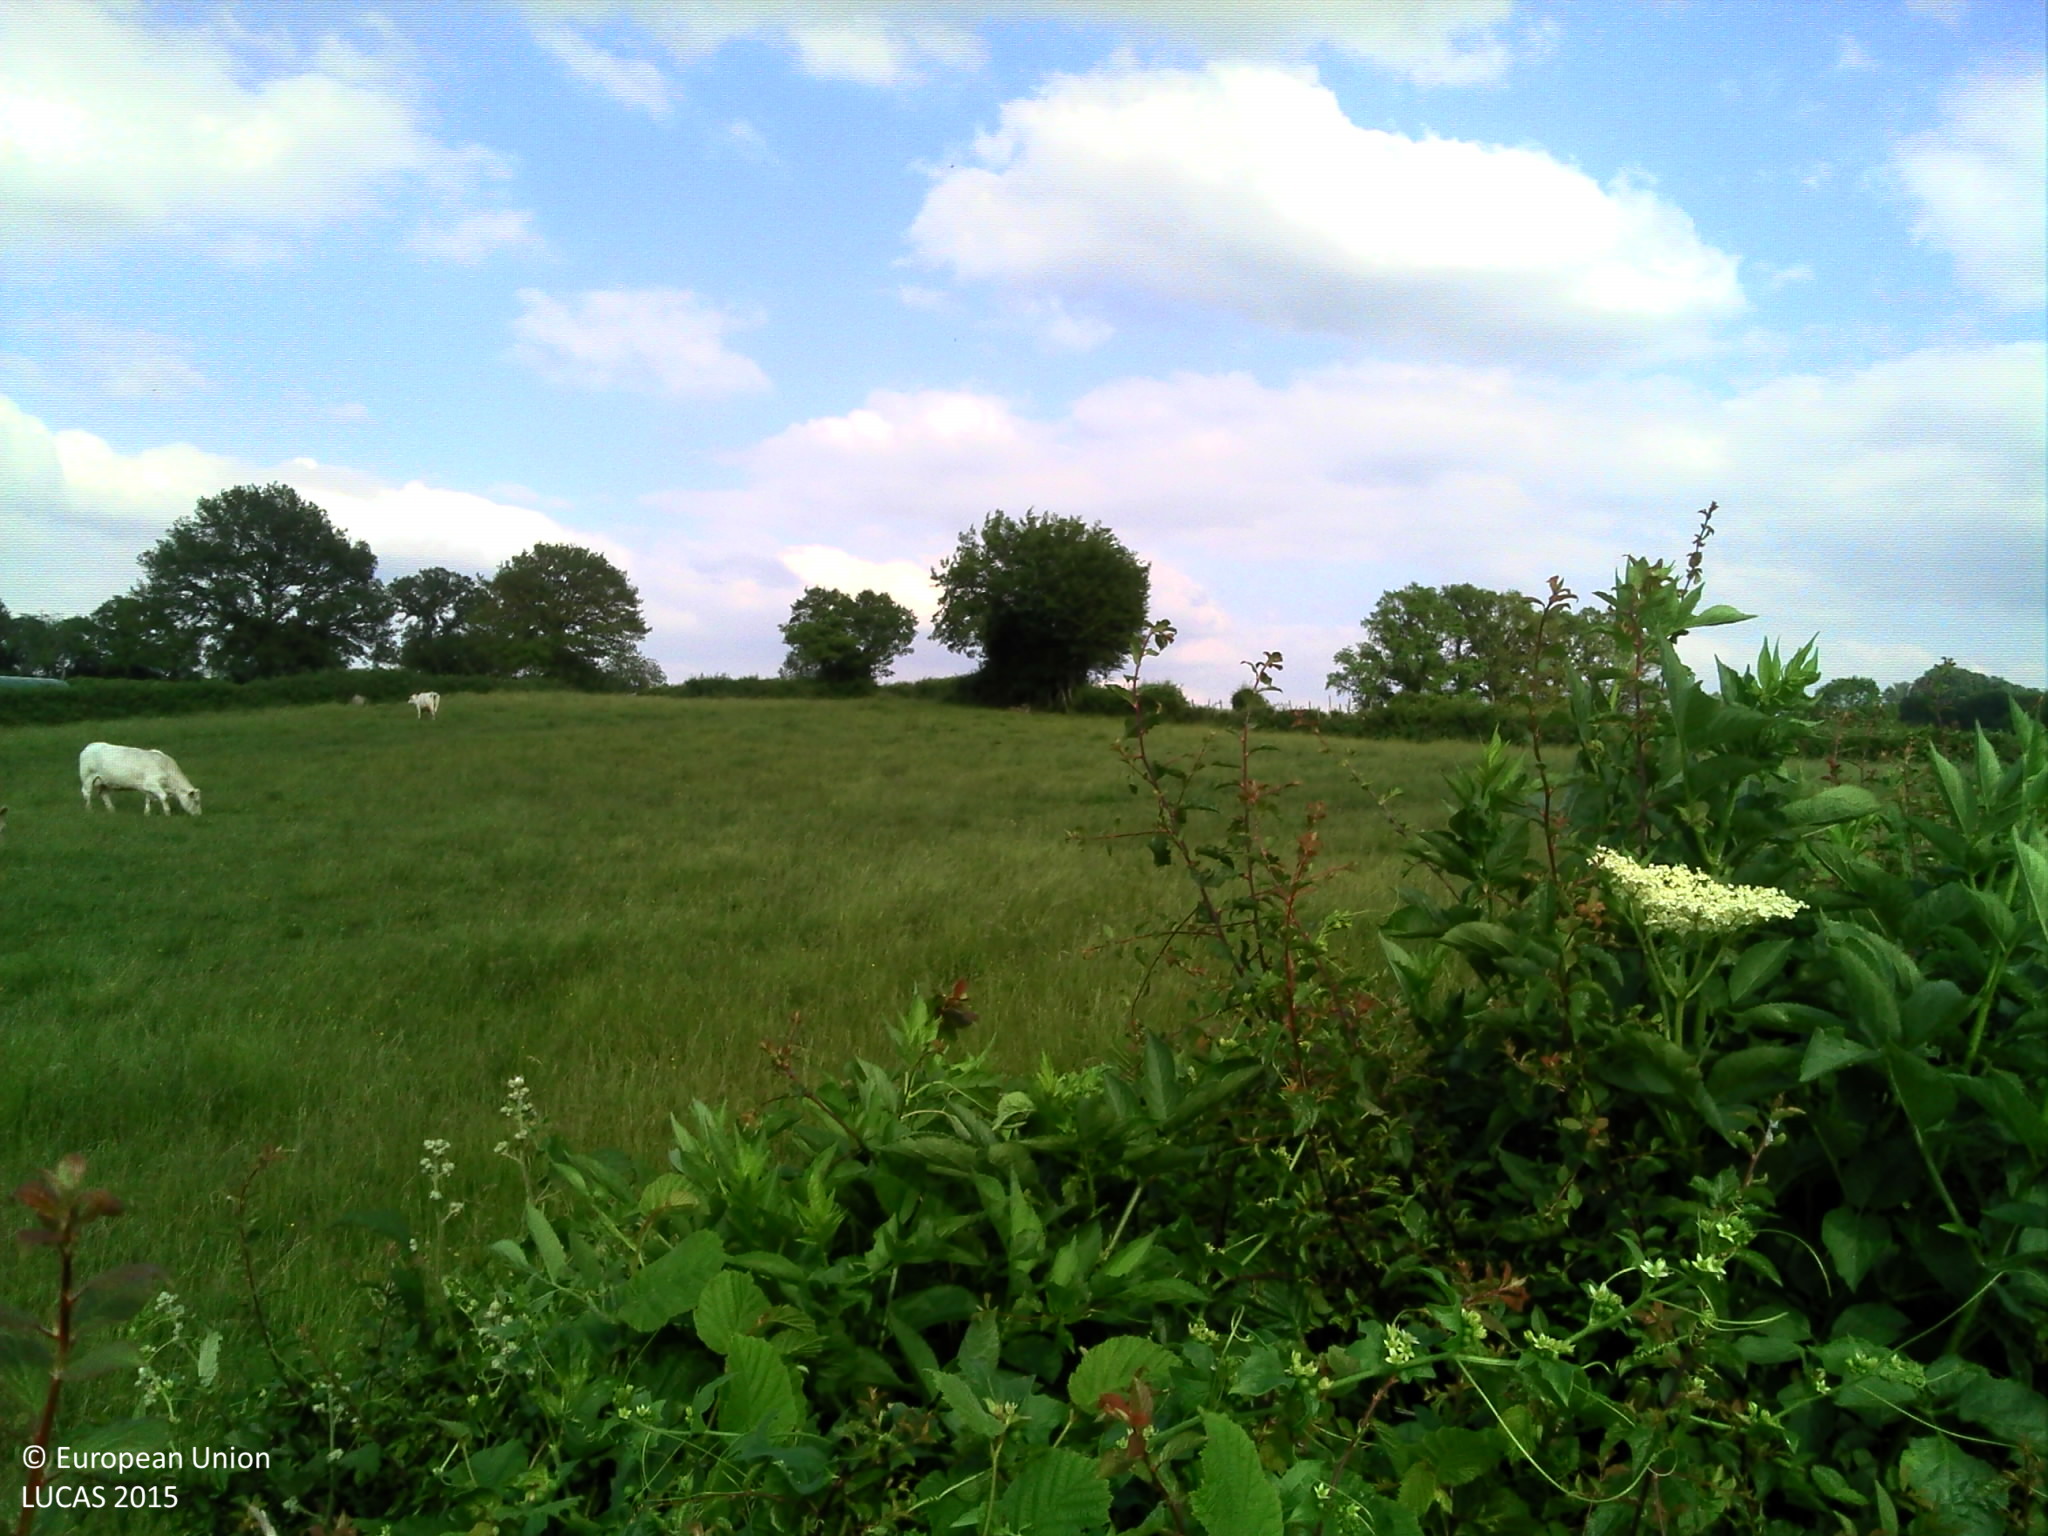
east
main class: Grassland
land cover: Grassland without tree/shrub cover
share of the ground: > 75 %
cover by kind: herbaceous plants 100 %
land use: Agriculture (excluding fallow land and kitchen gardens)
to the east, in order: Grassland without tree/shrub cover; Fences; Managed hedges; Grass margins; Tracks; Grass margins; Fences; Grassland without tree/shrub cover; Fences; Managed hedges; Grassland without tree/shrub cover; Fences; Managed hedges; Grassland without tree/shrub cover; Fences; Broadleaved woodland; Grassland without tree/shrub cover
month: June
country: FR
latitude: 47.3908
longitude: 3.9702
